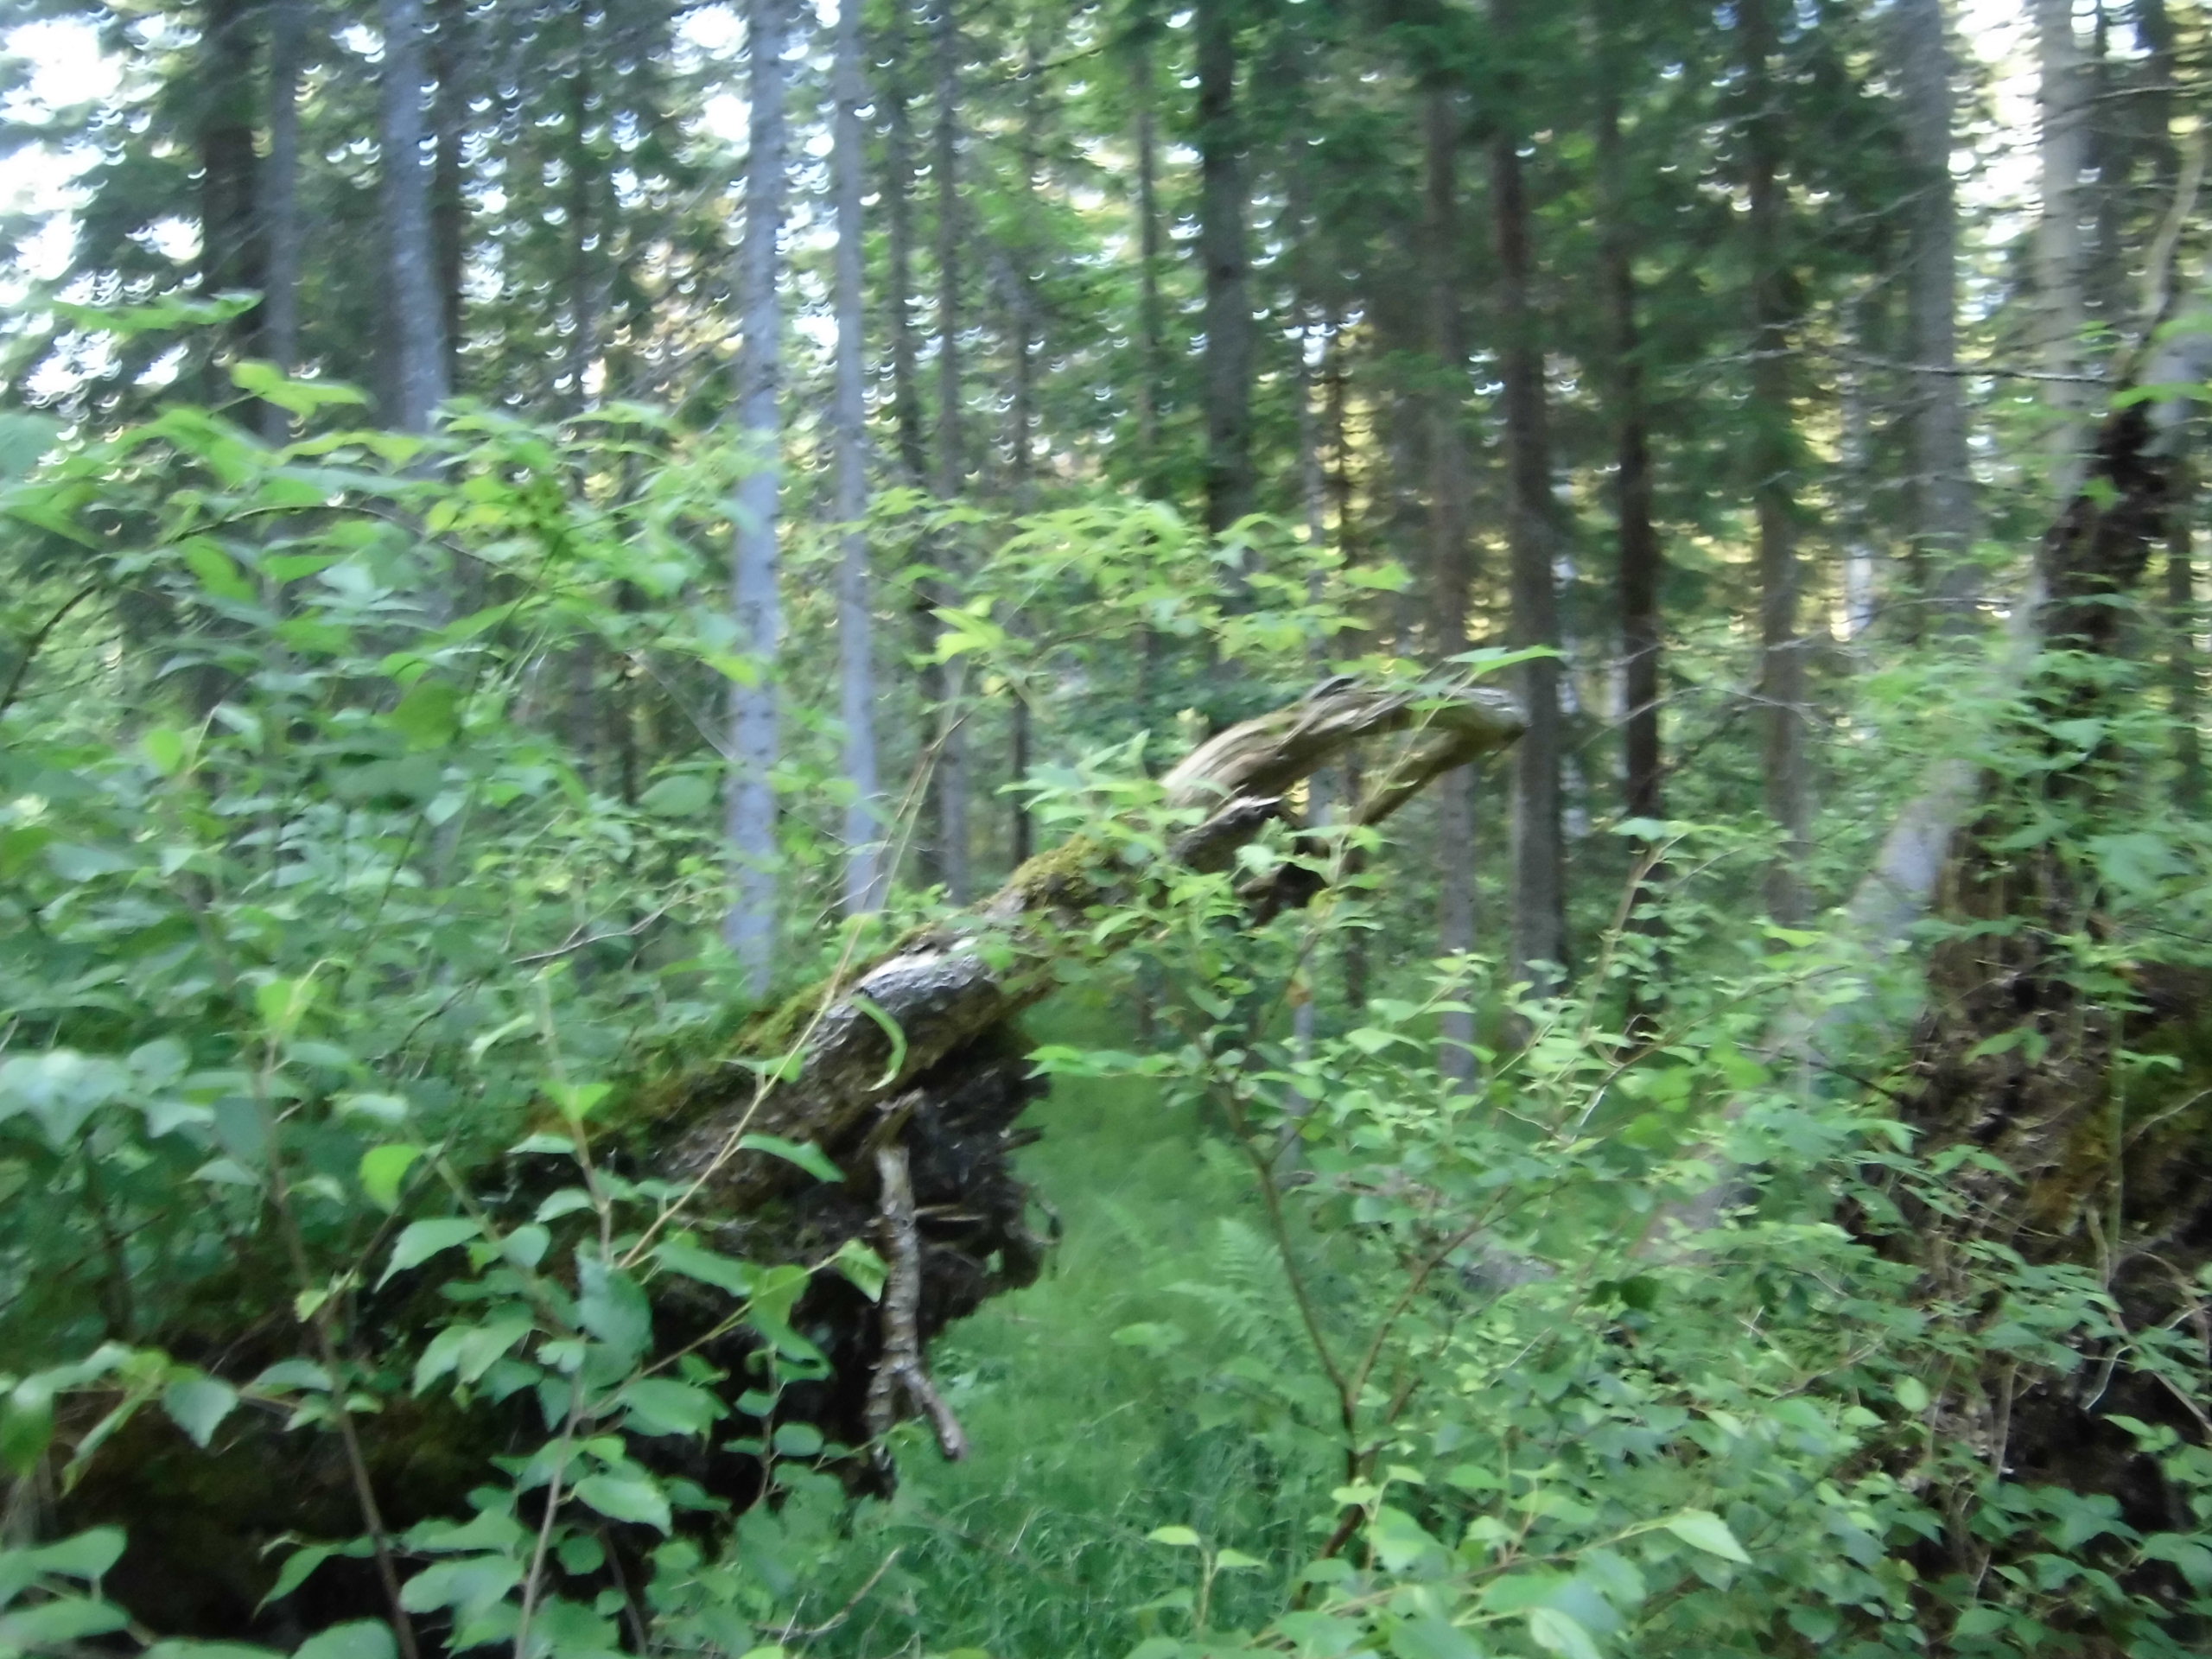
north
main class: Woodland
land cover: Spruce dominated mixed woodland
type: boreal forest
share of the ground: 50 - 75 %
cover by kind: coniferous forest trees 35 %, broadleaved forest trees 25 %, herbaceous plants 20 %, shrubs 10 %, lichens and mosses 10 %
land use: Forestry
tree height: > 5 m
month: July
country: SE
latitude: 57.3964
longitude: 15.2383
